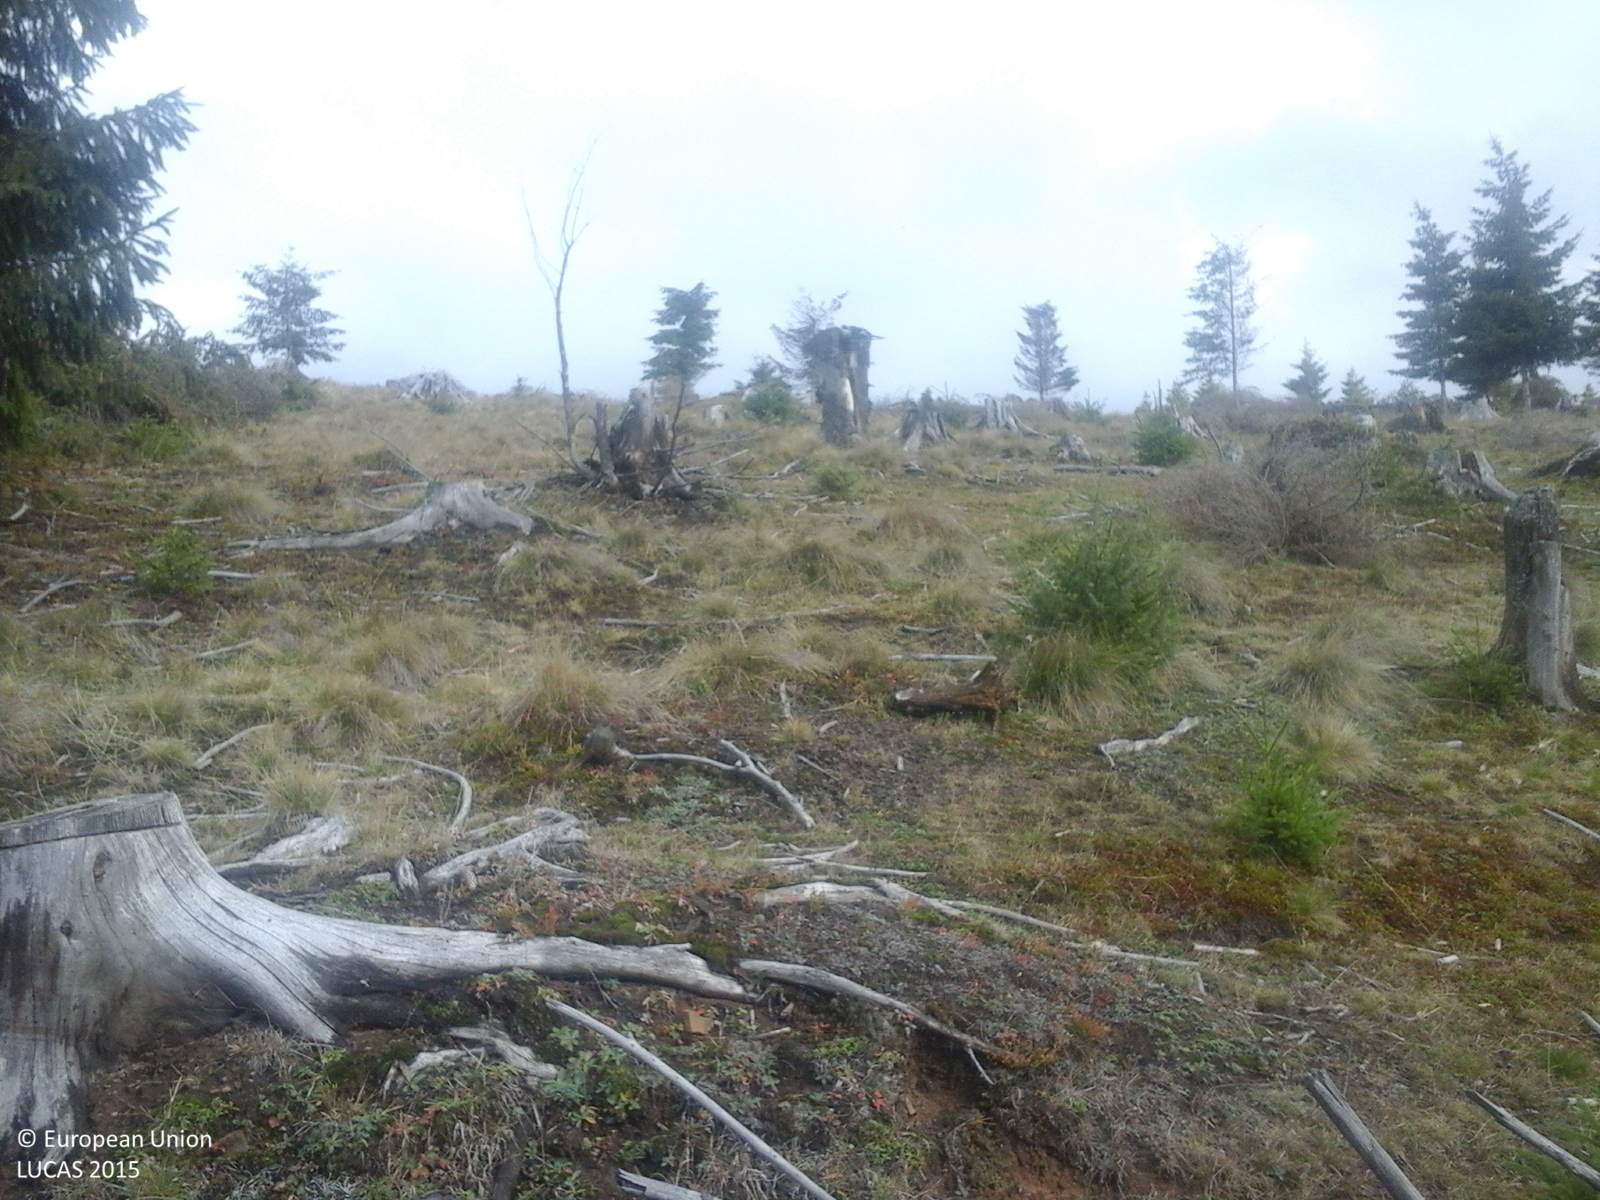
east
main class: Grassland
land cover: Grassland with sparse tree/shrub cover
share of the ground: > 75 %
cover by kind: herbaceous plants 85 %, shrubs 10 %, broadleaved forest trees 5 %
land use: Forestry
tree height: < 5 m
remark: Clear cut
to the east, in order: Grassland with sparse tree/shrub cover
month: October
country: RO
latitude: 46.5038
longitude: 26.0597
